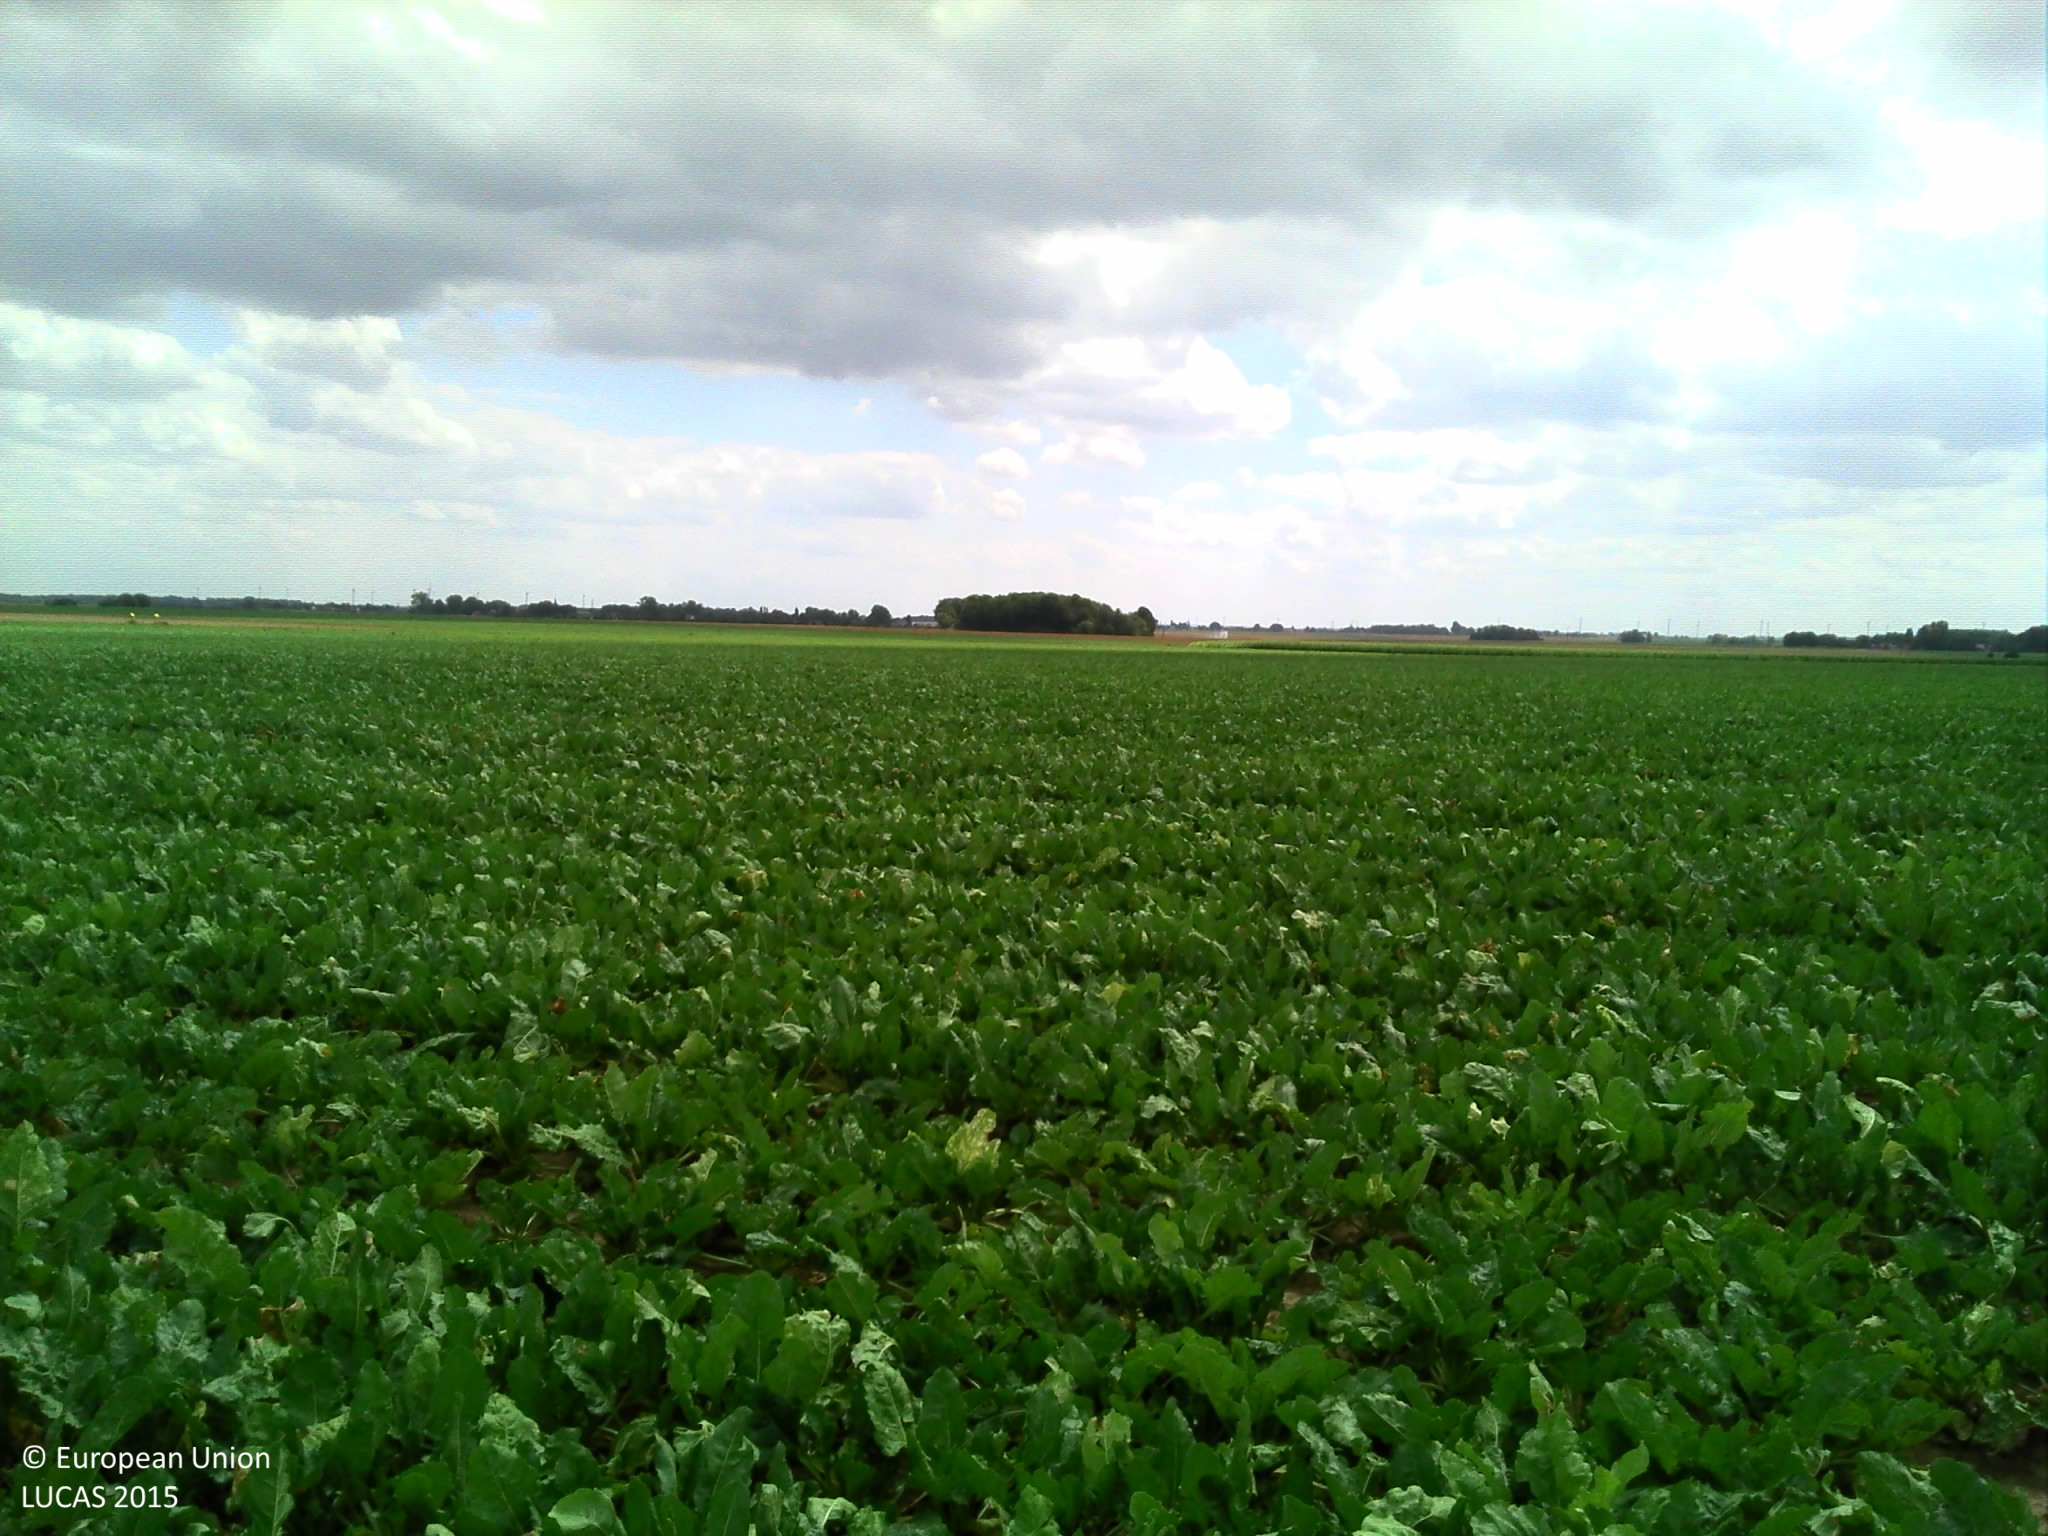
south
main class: Cropland
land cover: Sugar beet
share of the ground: > 75 %
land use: Agriculture (excluding fallow land and kitchen gardens)
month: August
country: FR
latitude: 49.8106
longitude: 2.7770
